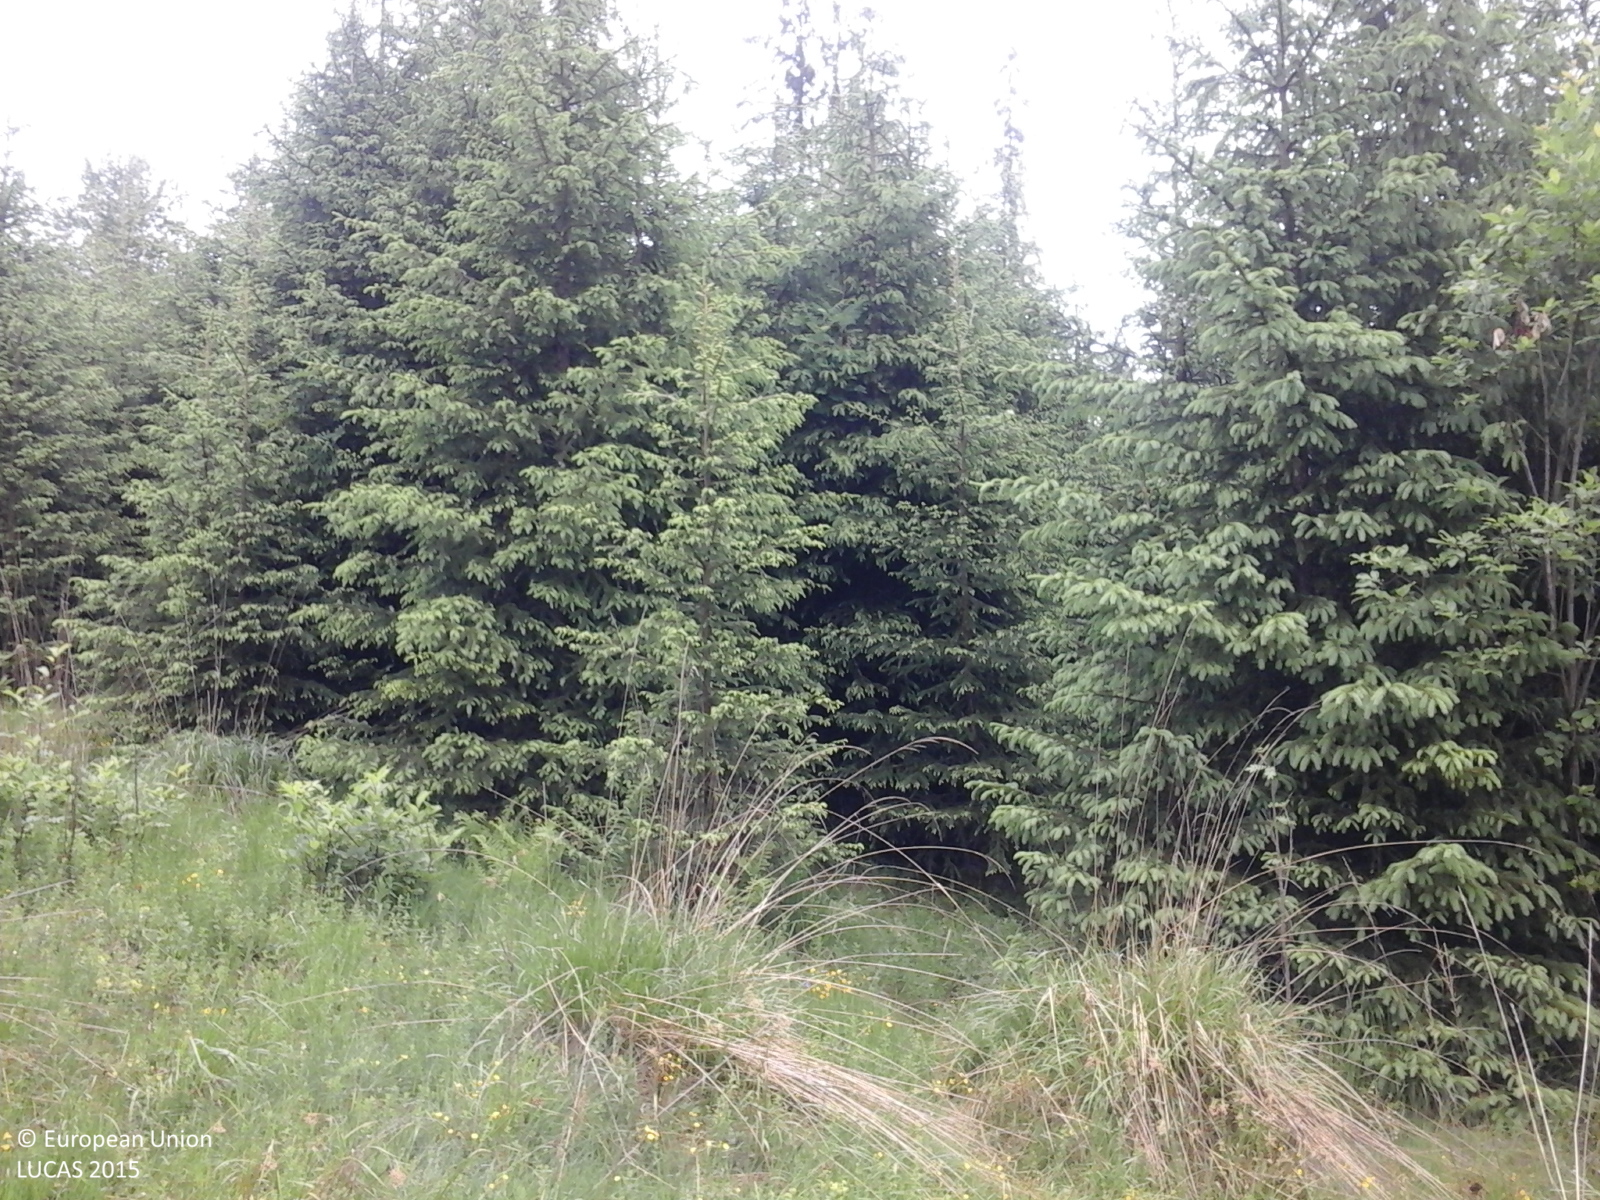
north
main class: Woodland
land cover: Spruce dominated coniferous woodland
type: alpine coniferous forest
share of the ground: > 75 %
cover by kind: coniferous forest trees 75 %, broadleaved forest trees 10 %, herbaceous plants 10 %, shrubs 5 %
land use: Forestry
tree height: > 5 m
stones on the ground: 25 - 50 %
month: June
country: RO
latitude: 47.4550
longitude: 25.3253
